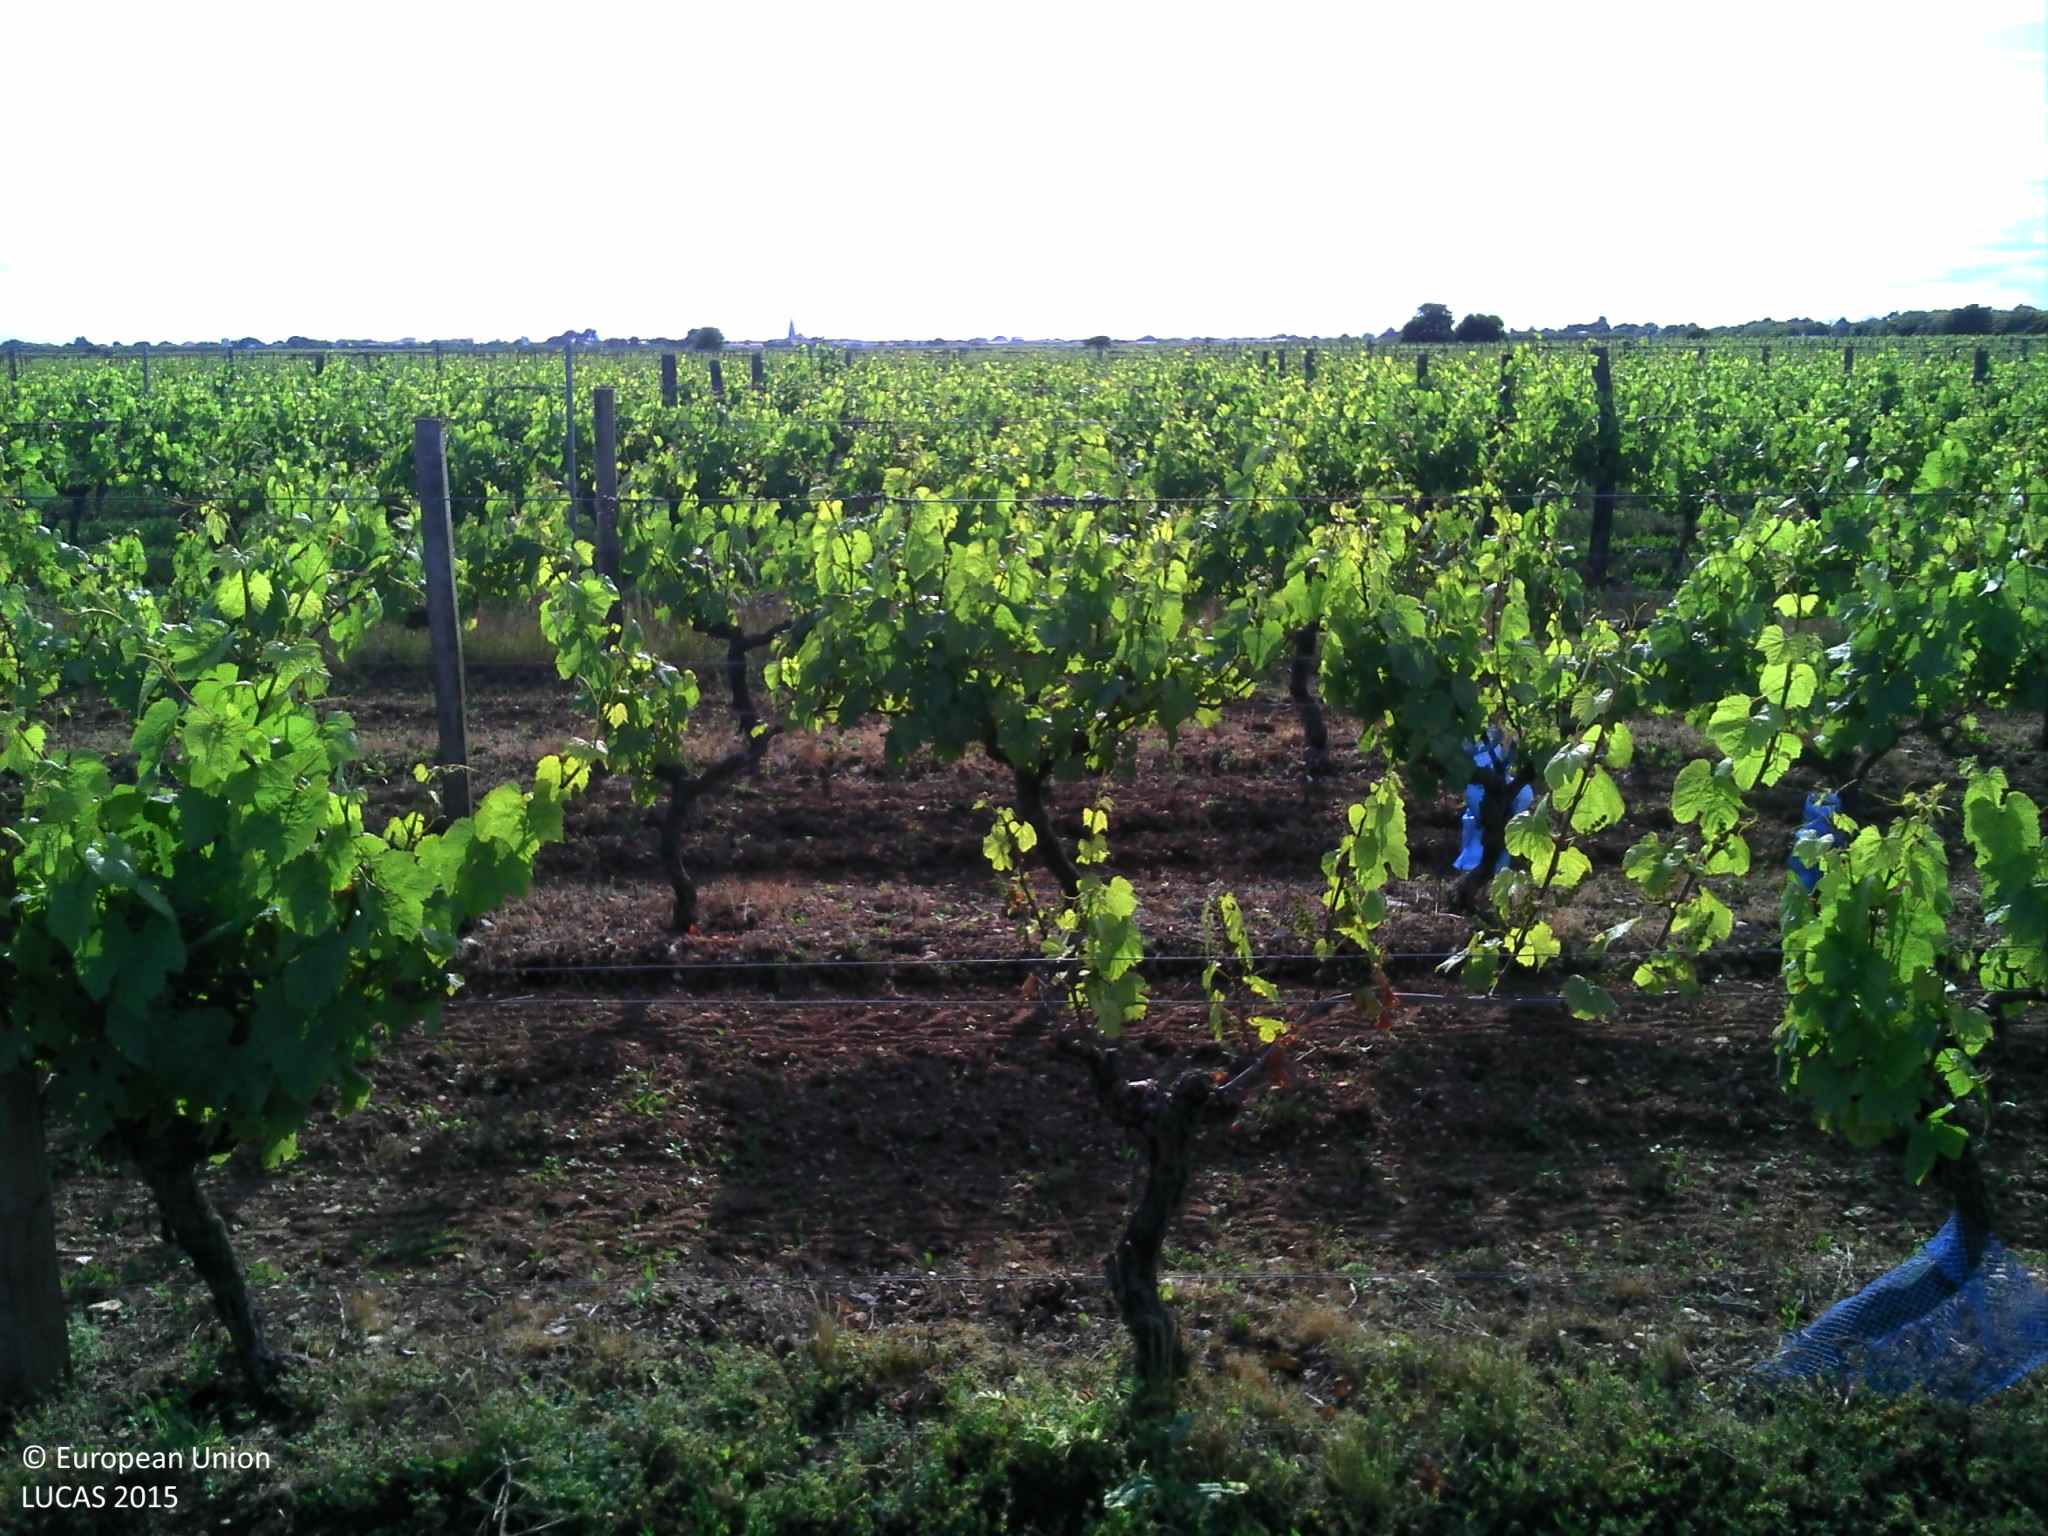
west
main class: Cropland
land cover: Vineyards
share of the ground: 25 - 50 %
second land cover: Other bare soil
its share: > 75 %
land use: Agriculture (excluding fallow land and kitchen gardens)
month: May
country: FR
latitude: 46.1519
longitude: -1.2851
